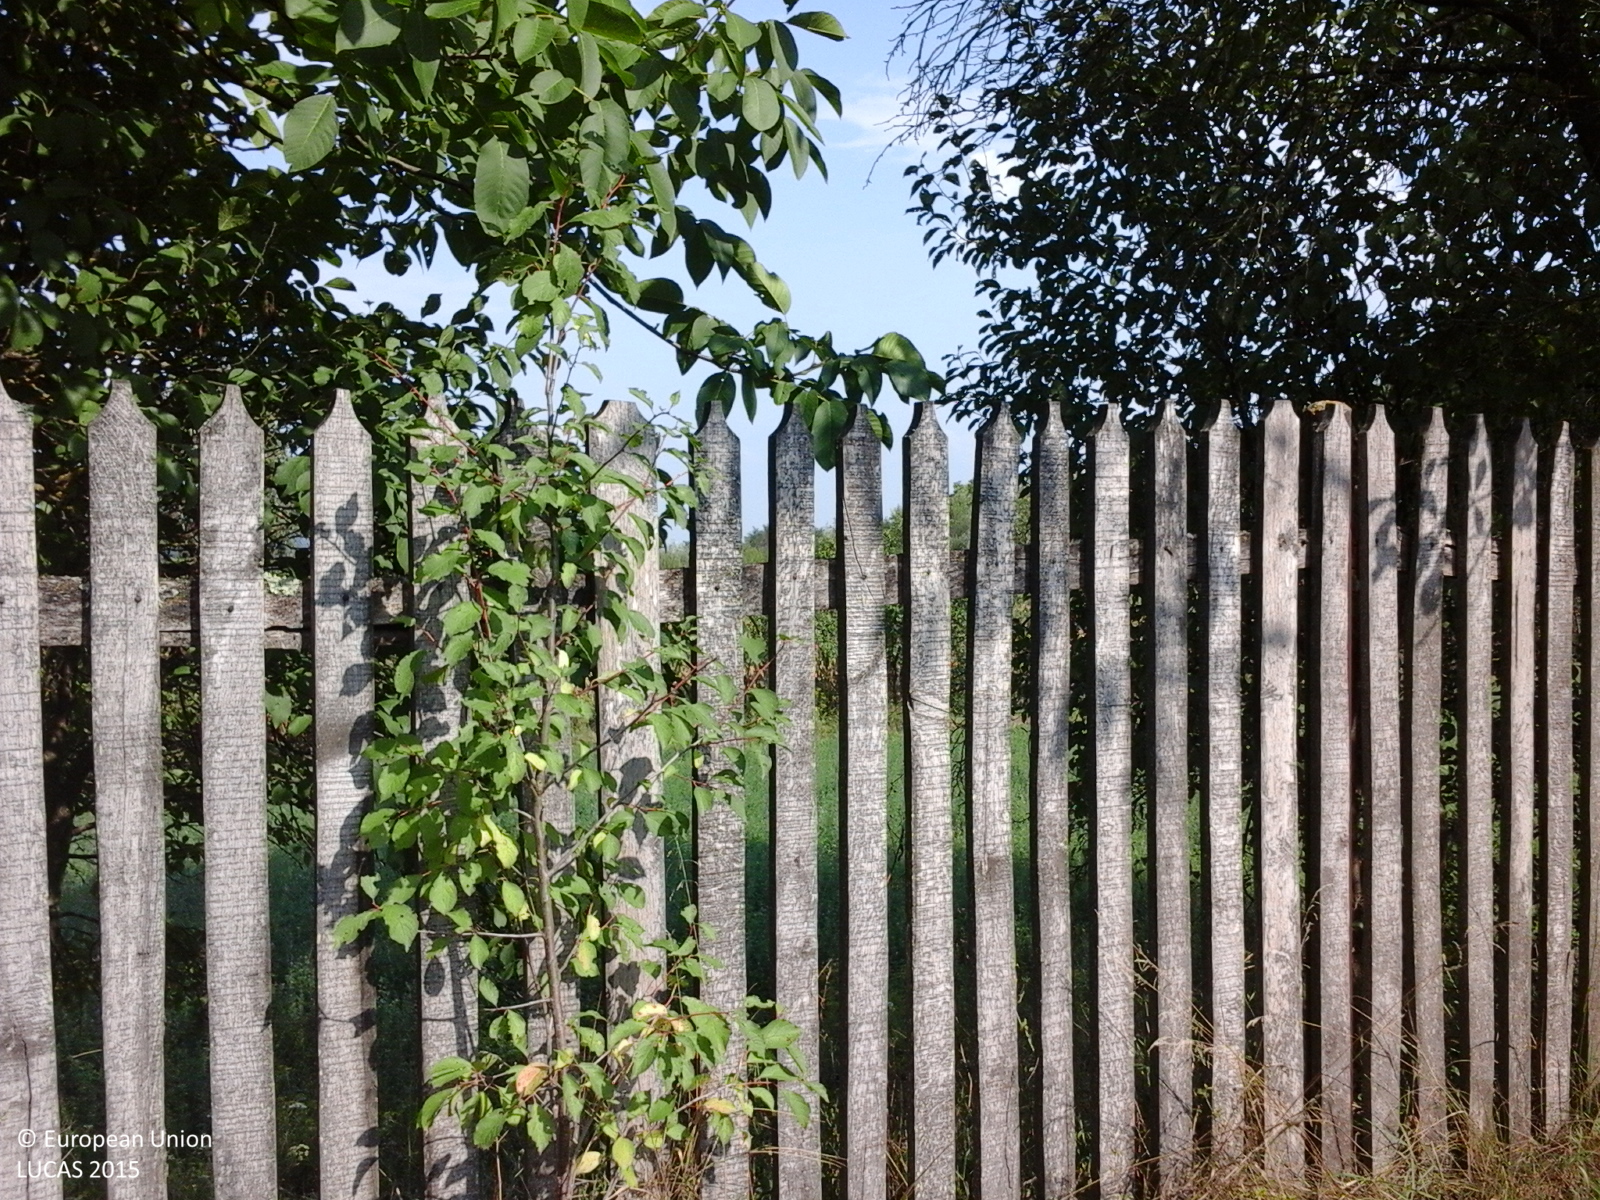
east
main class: Cropland
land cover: Maize
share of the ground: > 75 %
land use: Agriculture (excluding fallow land and kitchen gardens)
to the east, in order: Maize; Abandoned hedges; Fences; Grass margins; Tracks; Grass margins; Artificial constructions; Grass margins; Fences; Abandoned hedges; Lucerne; Abandoned hedges; Fences; Maize; Abandoned hedges; Grassland without tree/shrub cover; Maize; Fences; Shrubland with sparse tree cover; Tracks; Grass margins; Spontaneously vegetated surfaces; Tracks; Spontaneously vegetated surfaces; Maize; Lucerne
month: August
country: RO
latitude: 46.1110
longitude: 21.8267
